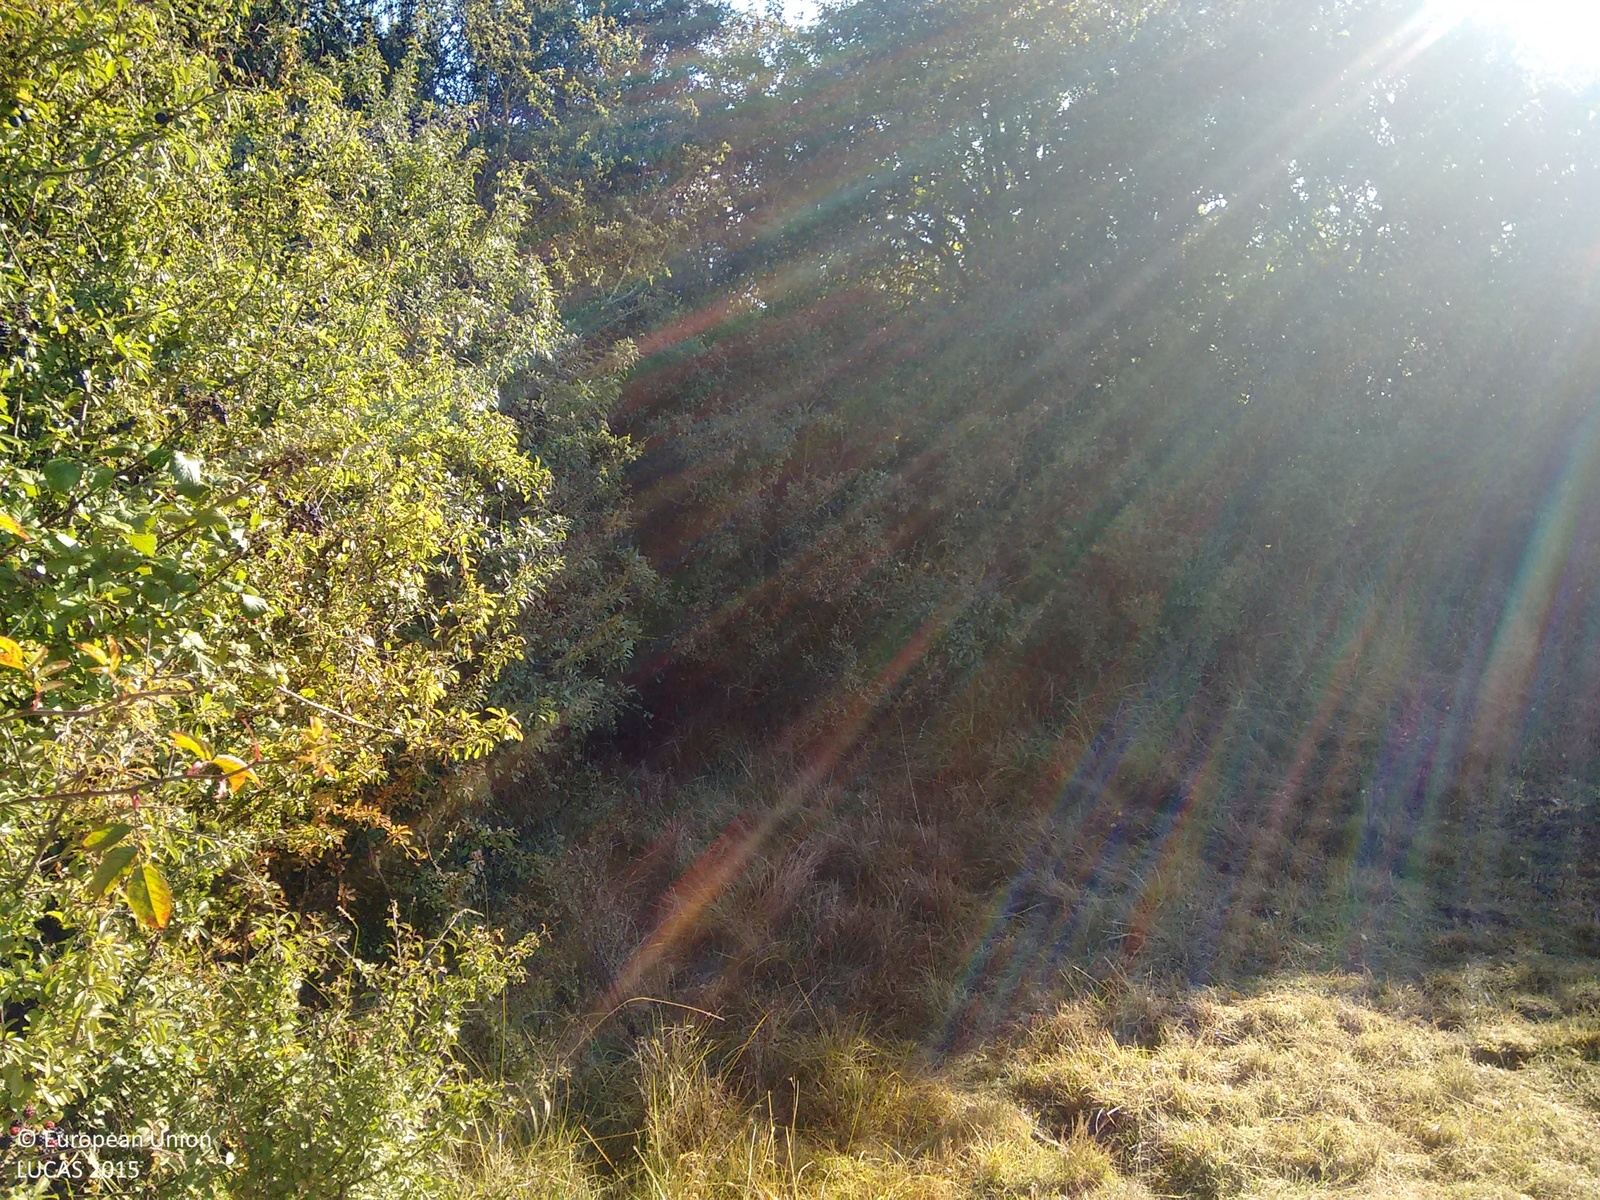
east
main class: Shrubland
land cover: Shrubland without tree cover
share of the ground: > 75 %
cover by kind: shrubs 100 %
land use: Agriculture (excluding fallow land and kitchen gardens)
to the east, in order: Shrubland without tree cover; Grassland without tree/shrub cover; Single bushes/trees; Rivers and streams; Spontaneously vegetated surfaces; Grassland without tree/shrub cover; Fences; Grassland without tree/shrub cover
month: September
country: GB
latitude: 52.3404
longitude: -0.3549
